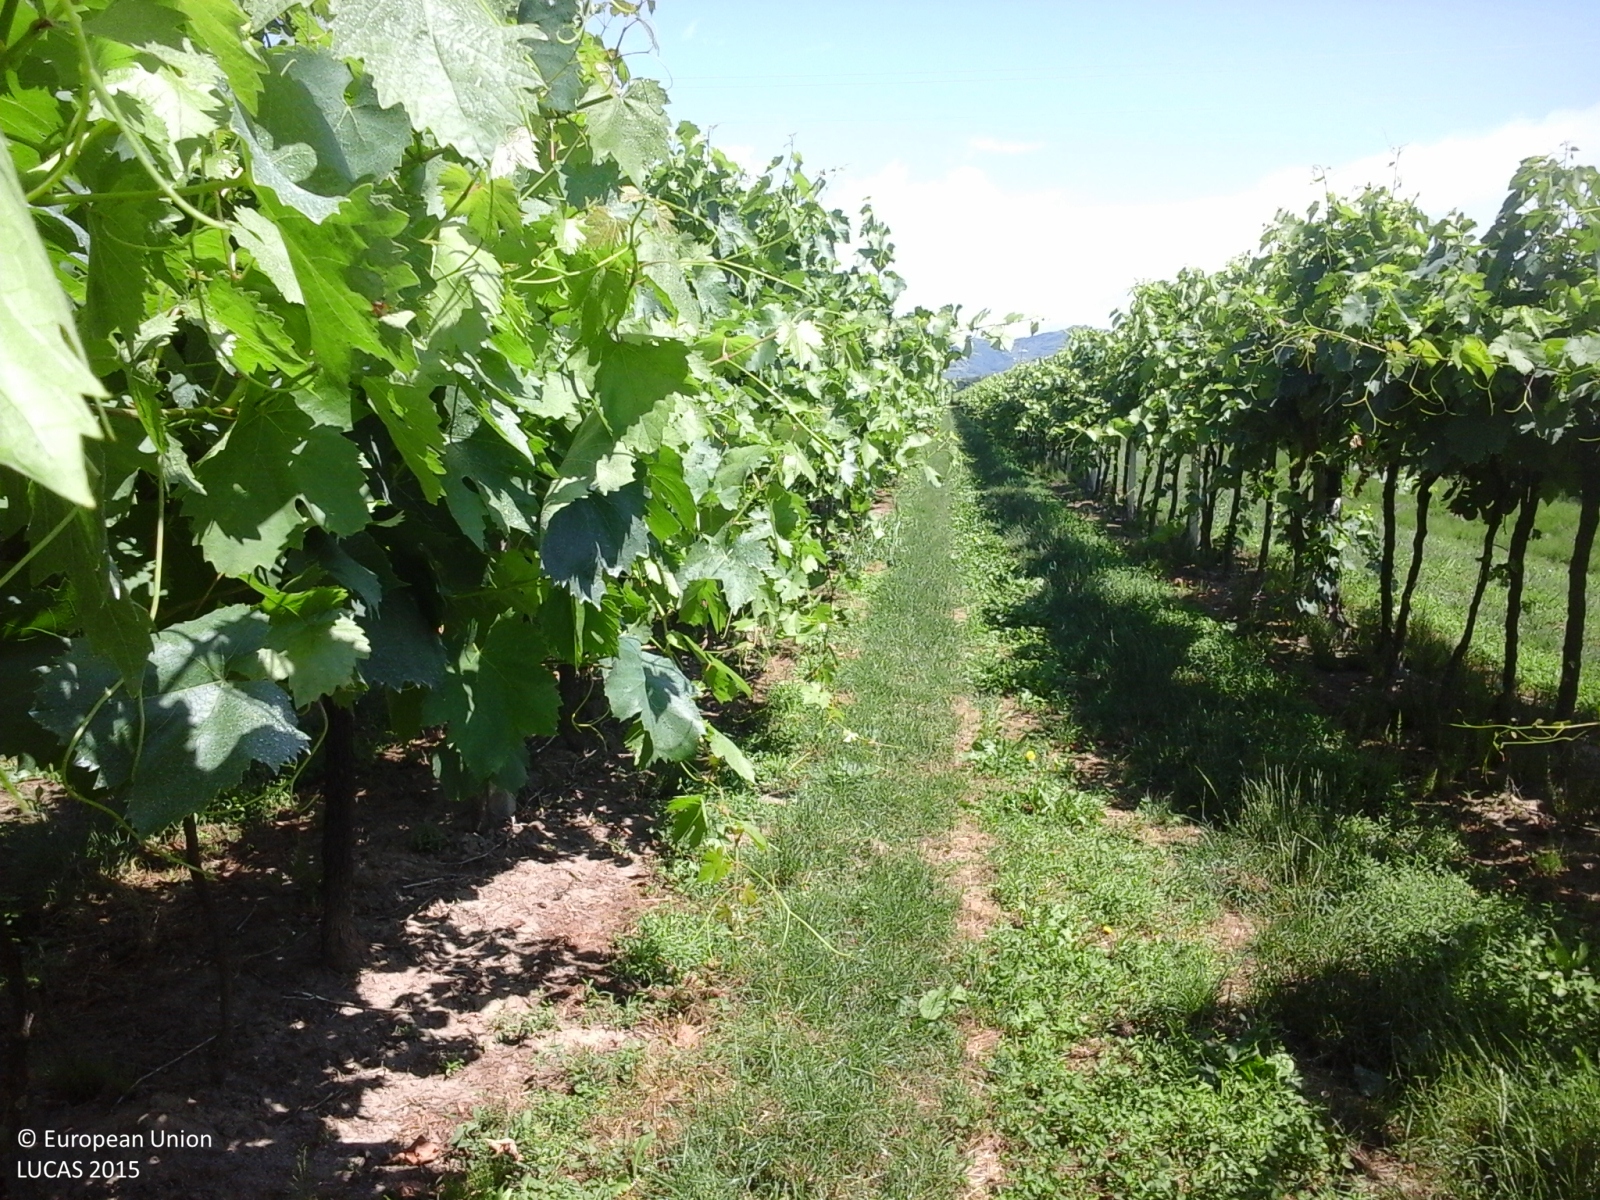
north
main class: Cropland
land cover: Vineyards
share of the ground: 50 - 75 %
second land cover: Grassland without tree/shrub cover
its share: > 75 %
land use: Agriculture (excluding fallow land and kitchen gardens)
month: June
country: IT
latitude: 45.3890
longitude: 11.2368
